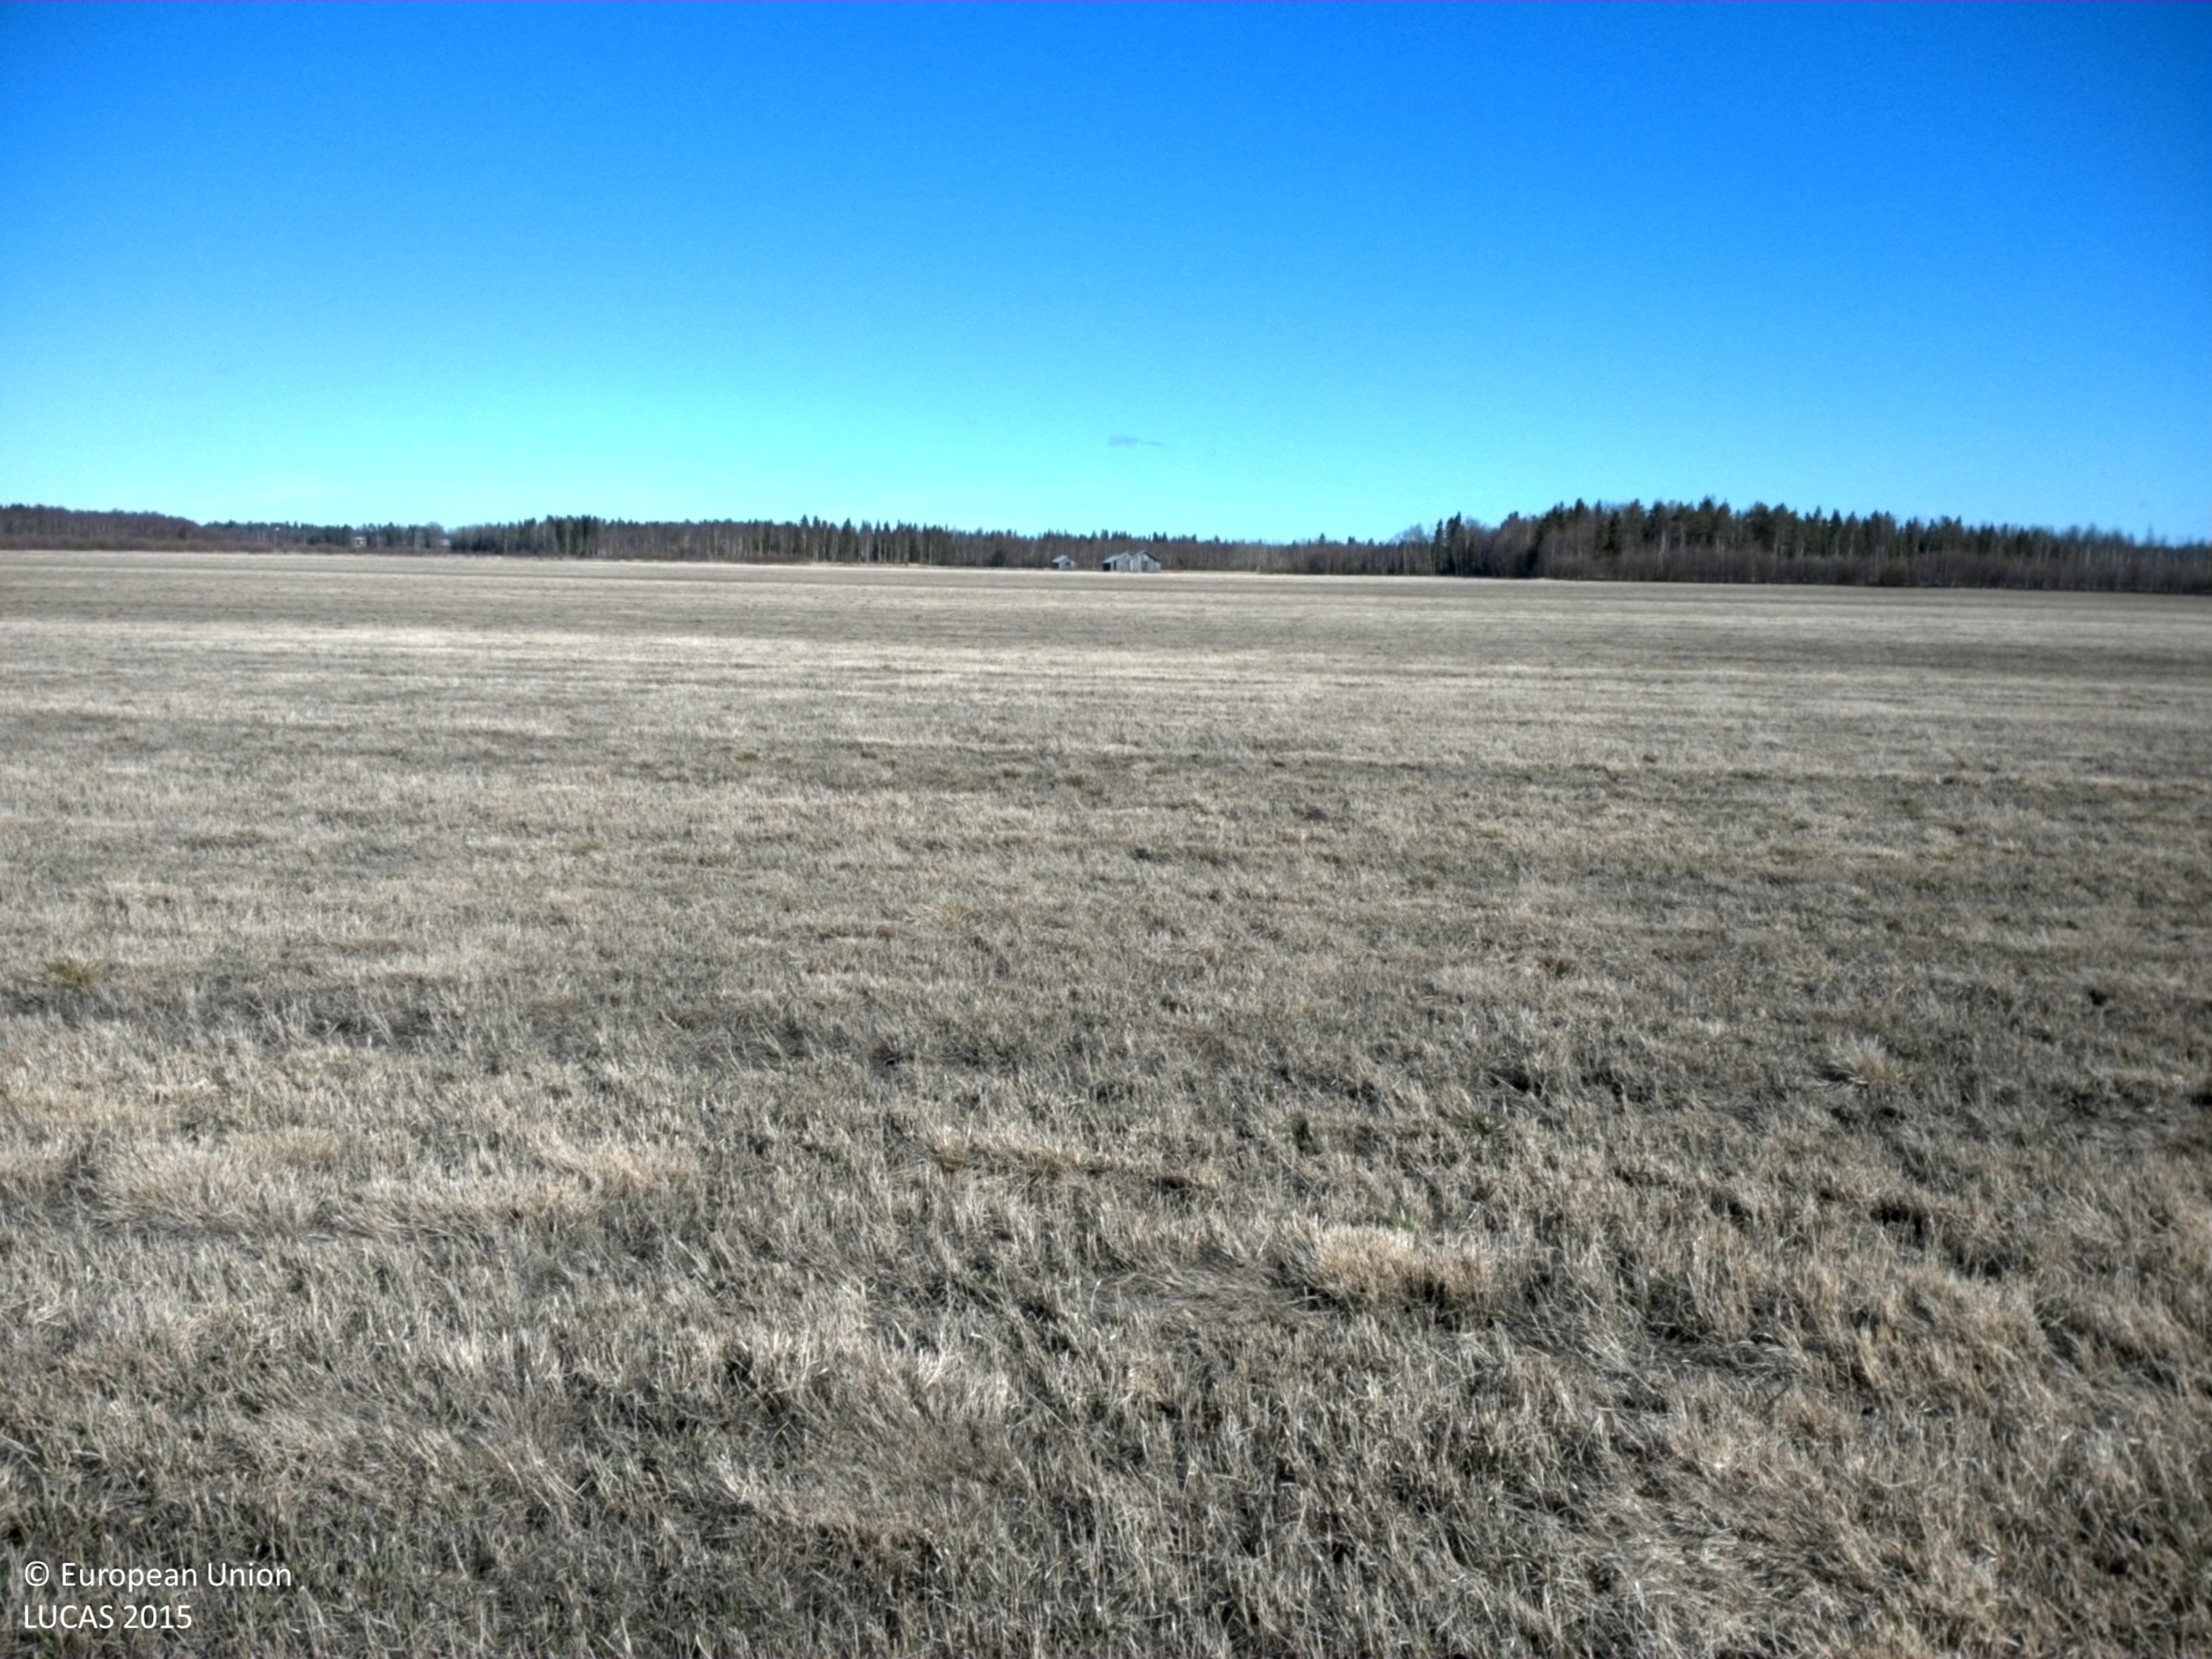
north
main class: Grassland
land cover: Grassland without tree/shrub cover
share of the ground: > 75 %
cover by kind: herbaceous plants 100 %
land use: Agriculture (excluding fallow land and kitchen gardens)
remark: Harvested field
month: May
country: SE
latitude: 65.8368
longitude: 23.1019
